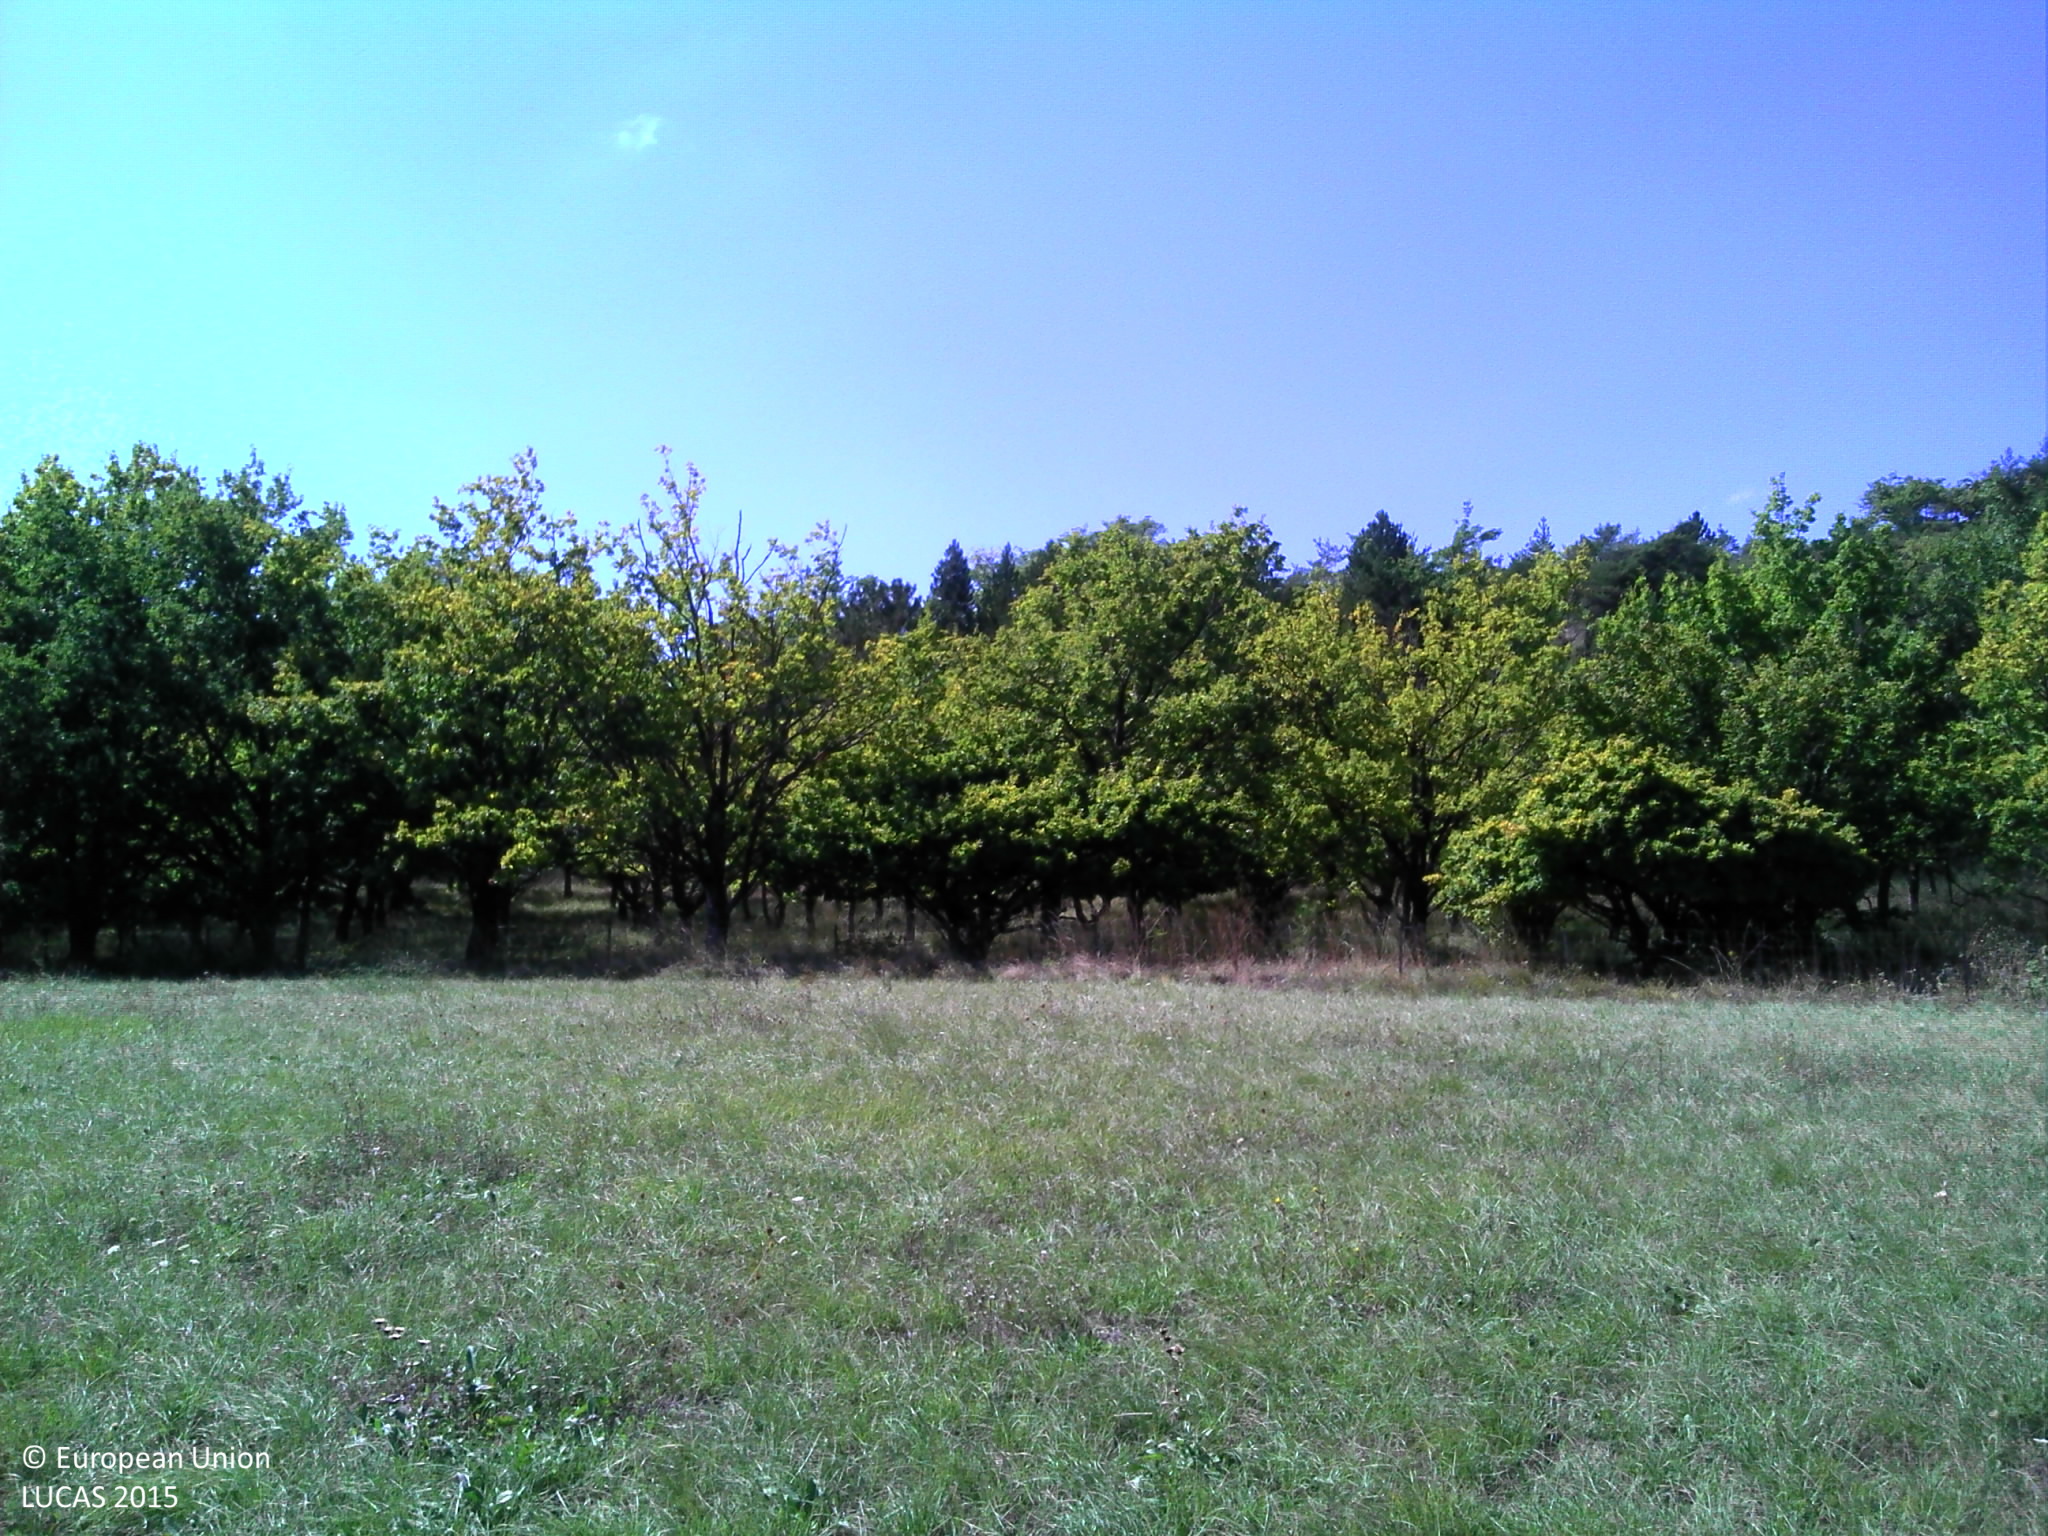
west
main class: Grassland
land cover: Grassland without tree/shrub cover
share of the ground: > 75 %
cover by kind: herbaceous plants 95 %, shrubs 5 %
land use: Agriculture (excluding fallow land and kitchen gardens)
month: September
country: FR
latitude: 44.5233
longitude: 5.0874
